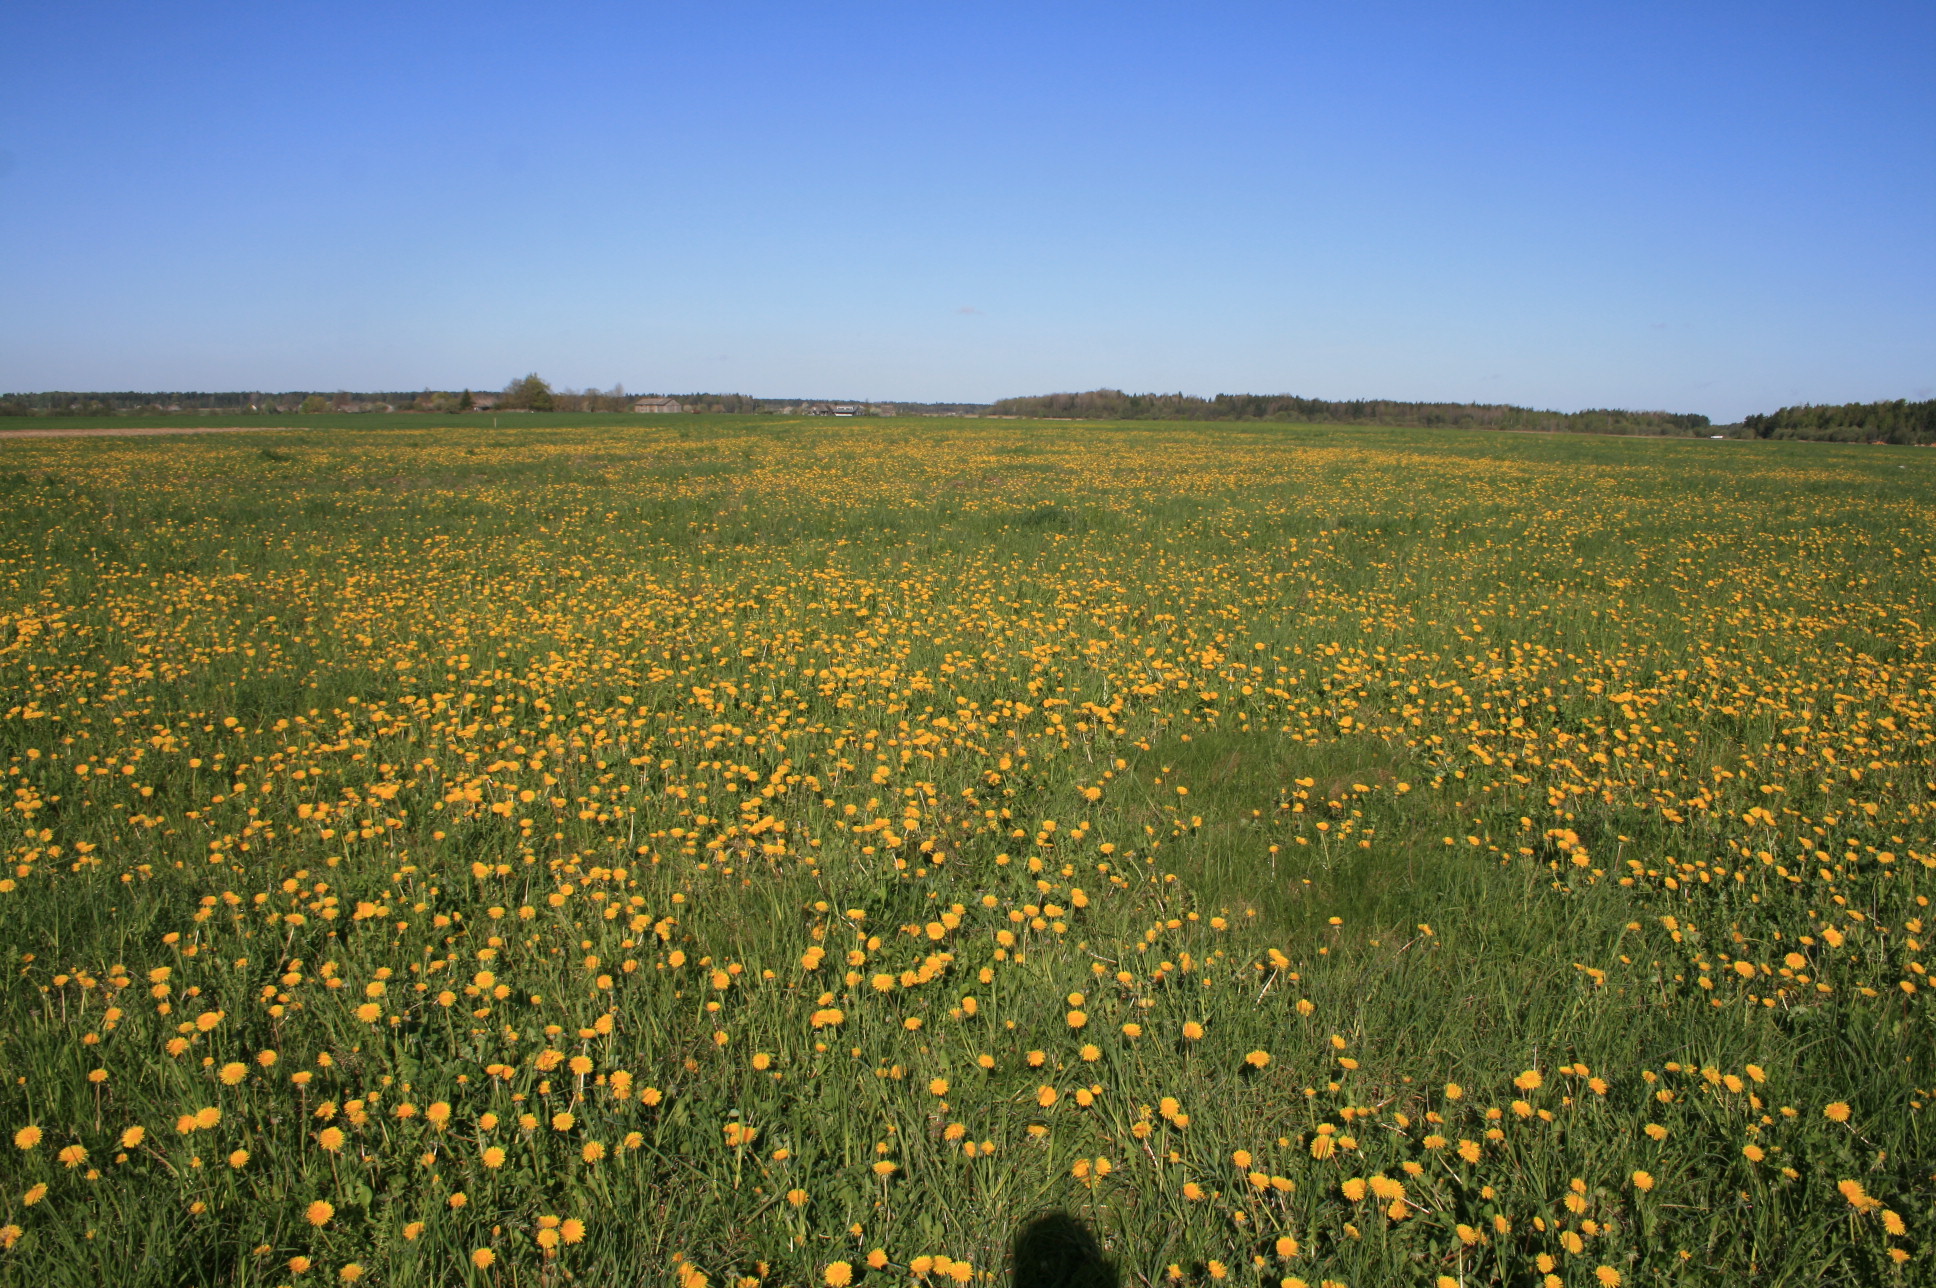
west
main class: Grassland
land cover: Grassland without tree/shrub cover
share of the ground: > 75 %
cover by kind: herbaceous plants 95 %, lichens and mosses 5 %
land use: Agriculture (excluding fallow land and kitchen gardens)
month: May
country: LT
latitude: 56.1045
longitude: 21.5076
